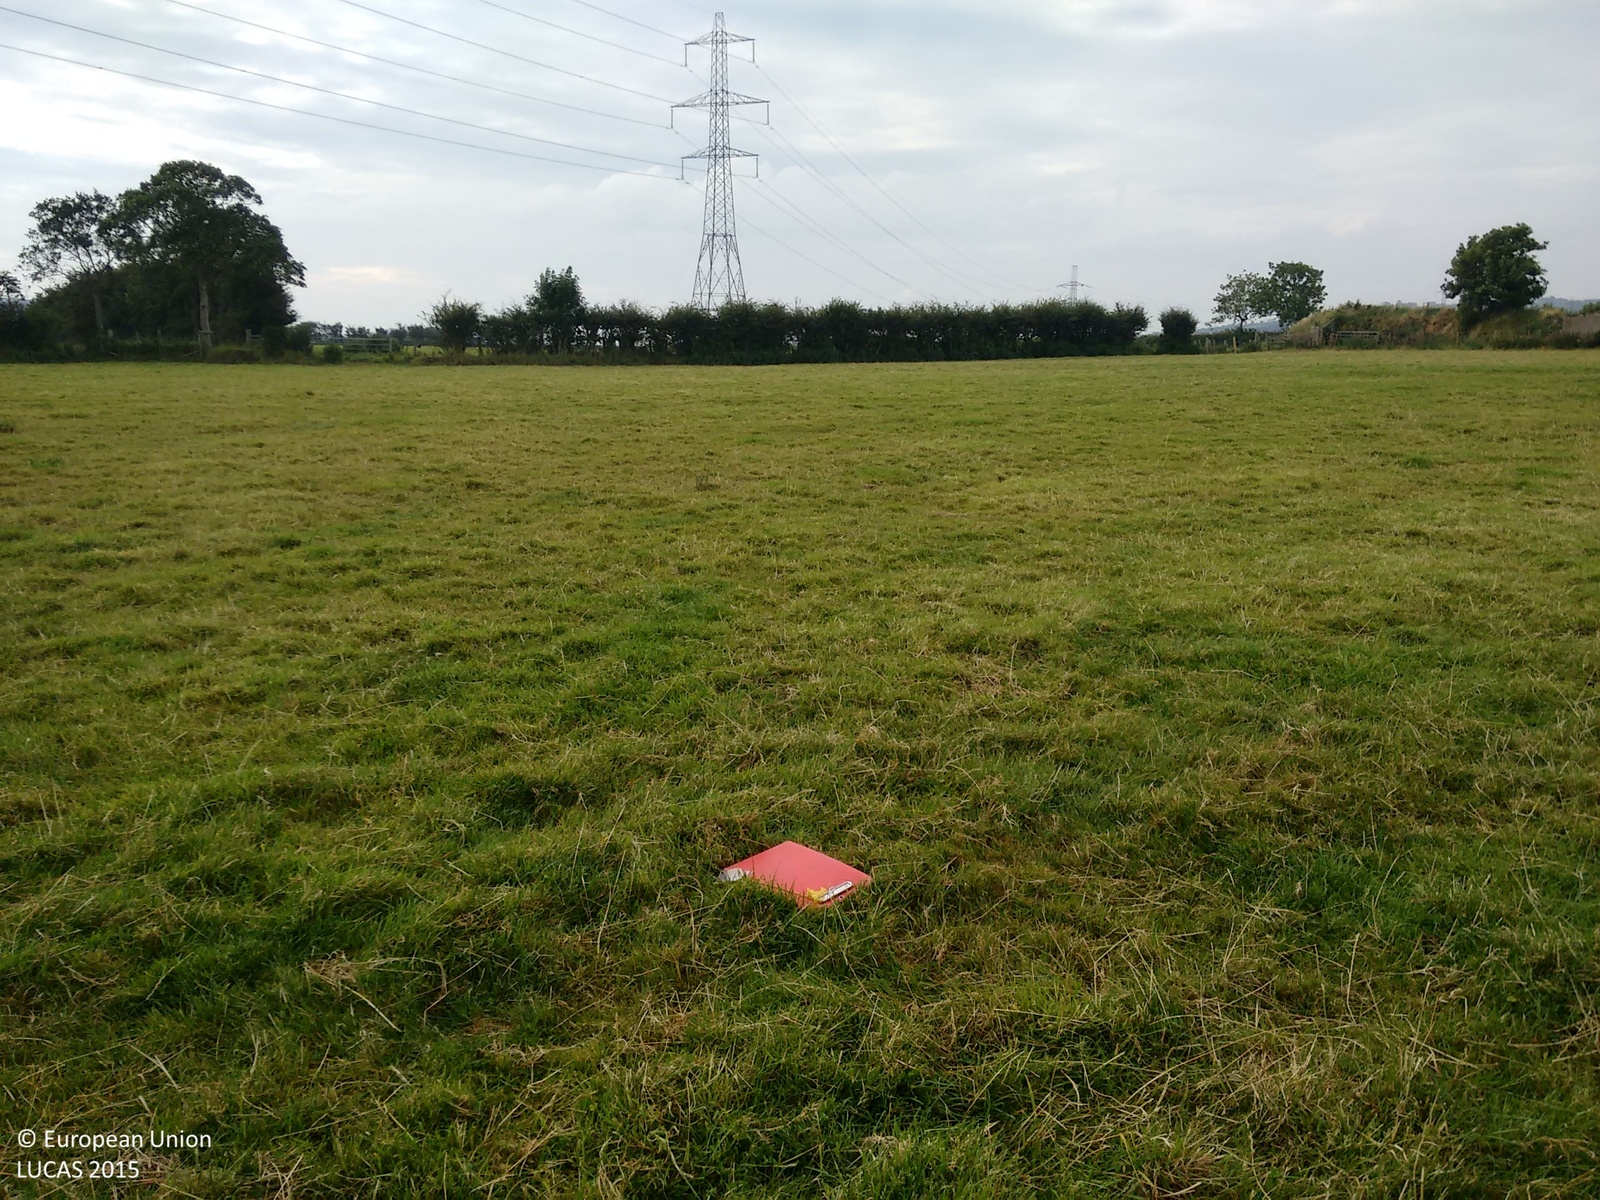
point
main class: Grassland
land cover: Grassland without tree/shrub cover
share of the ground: > 75 %
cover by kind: herbaceous plants 100 %
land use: Agriculture (excluding fallow land and kitchen gardens)
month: September
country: GB
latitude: 54.8212
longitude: -5.7435
